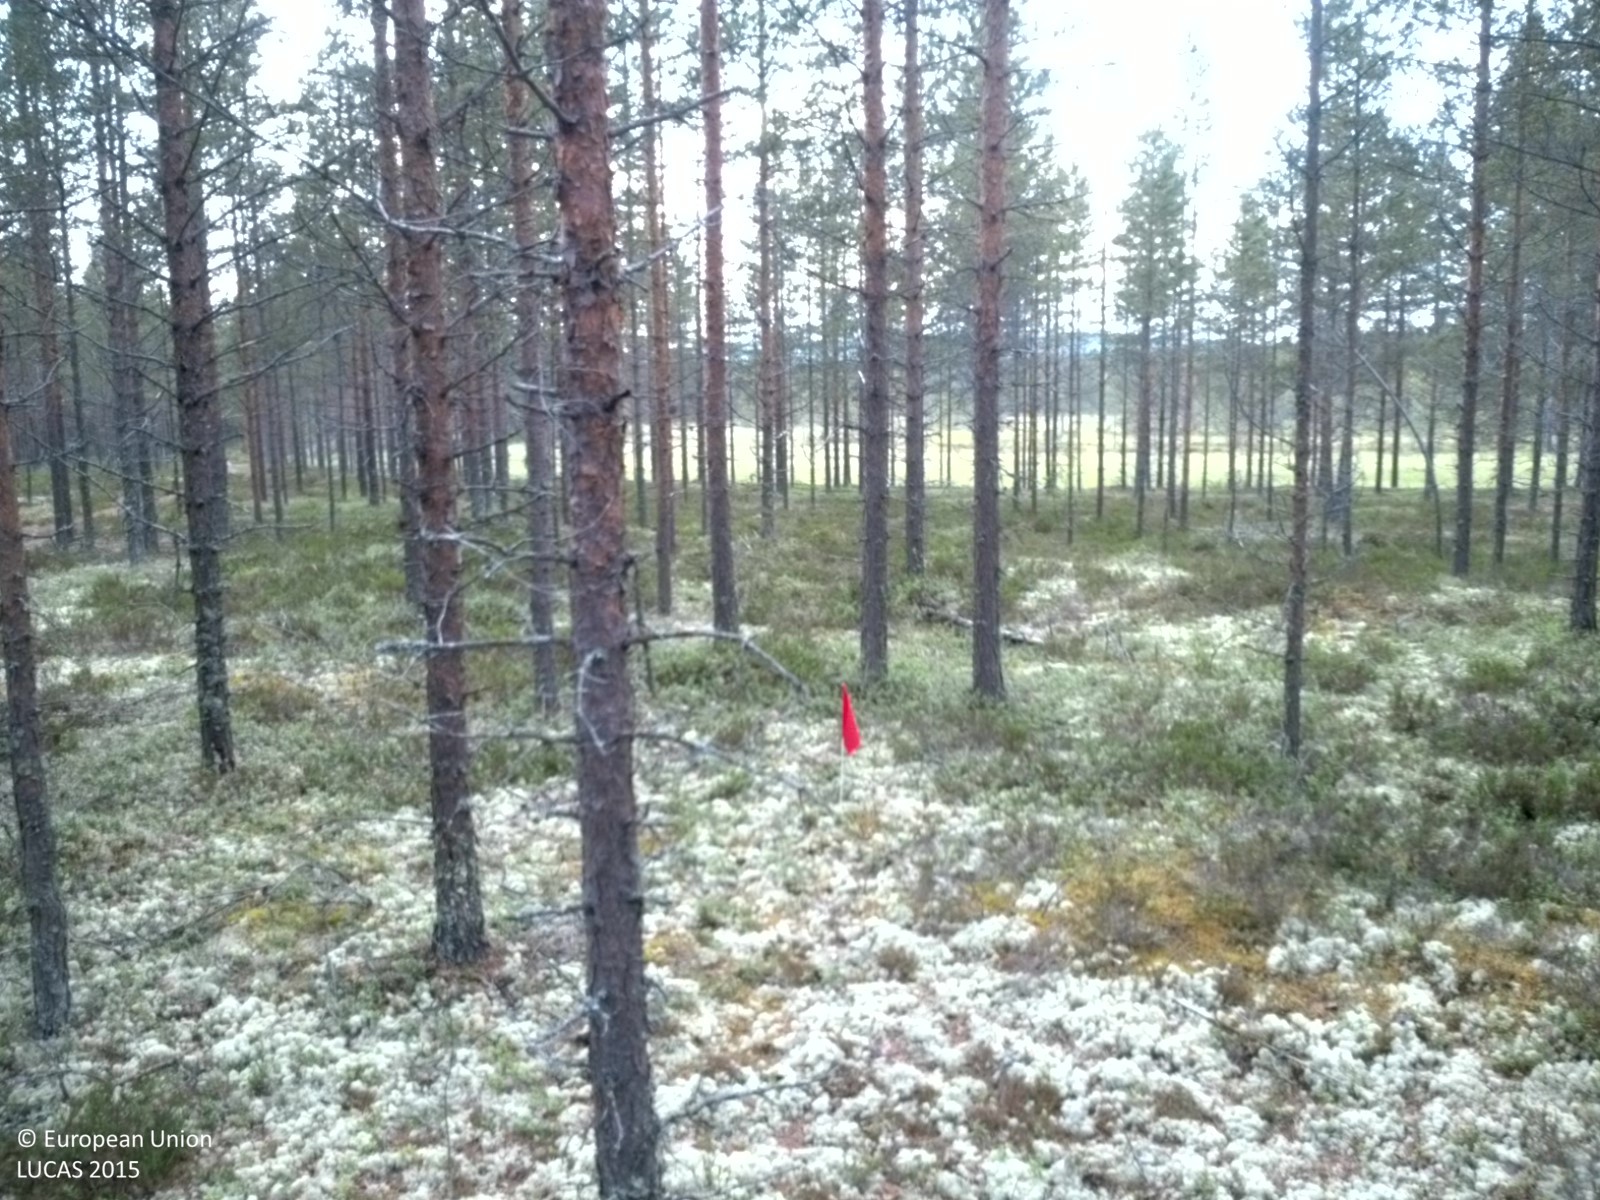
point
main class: Woodland
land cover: Pine dominated coniferous woodland
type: boreal forest
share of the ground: 25 - 50 %
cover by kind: lichens and mosses 75 %, coniferous forest trees 25 %
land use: Forestry
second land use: Amenities, museums, leisure
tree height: > 5 m
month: July
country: SE
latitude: 63.5893
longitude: 19.4297
